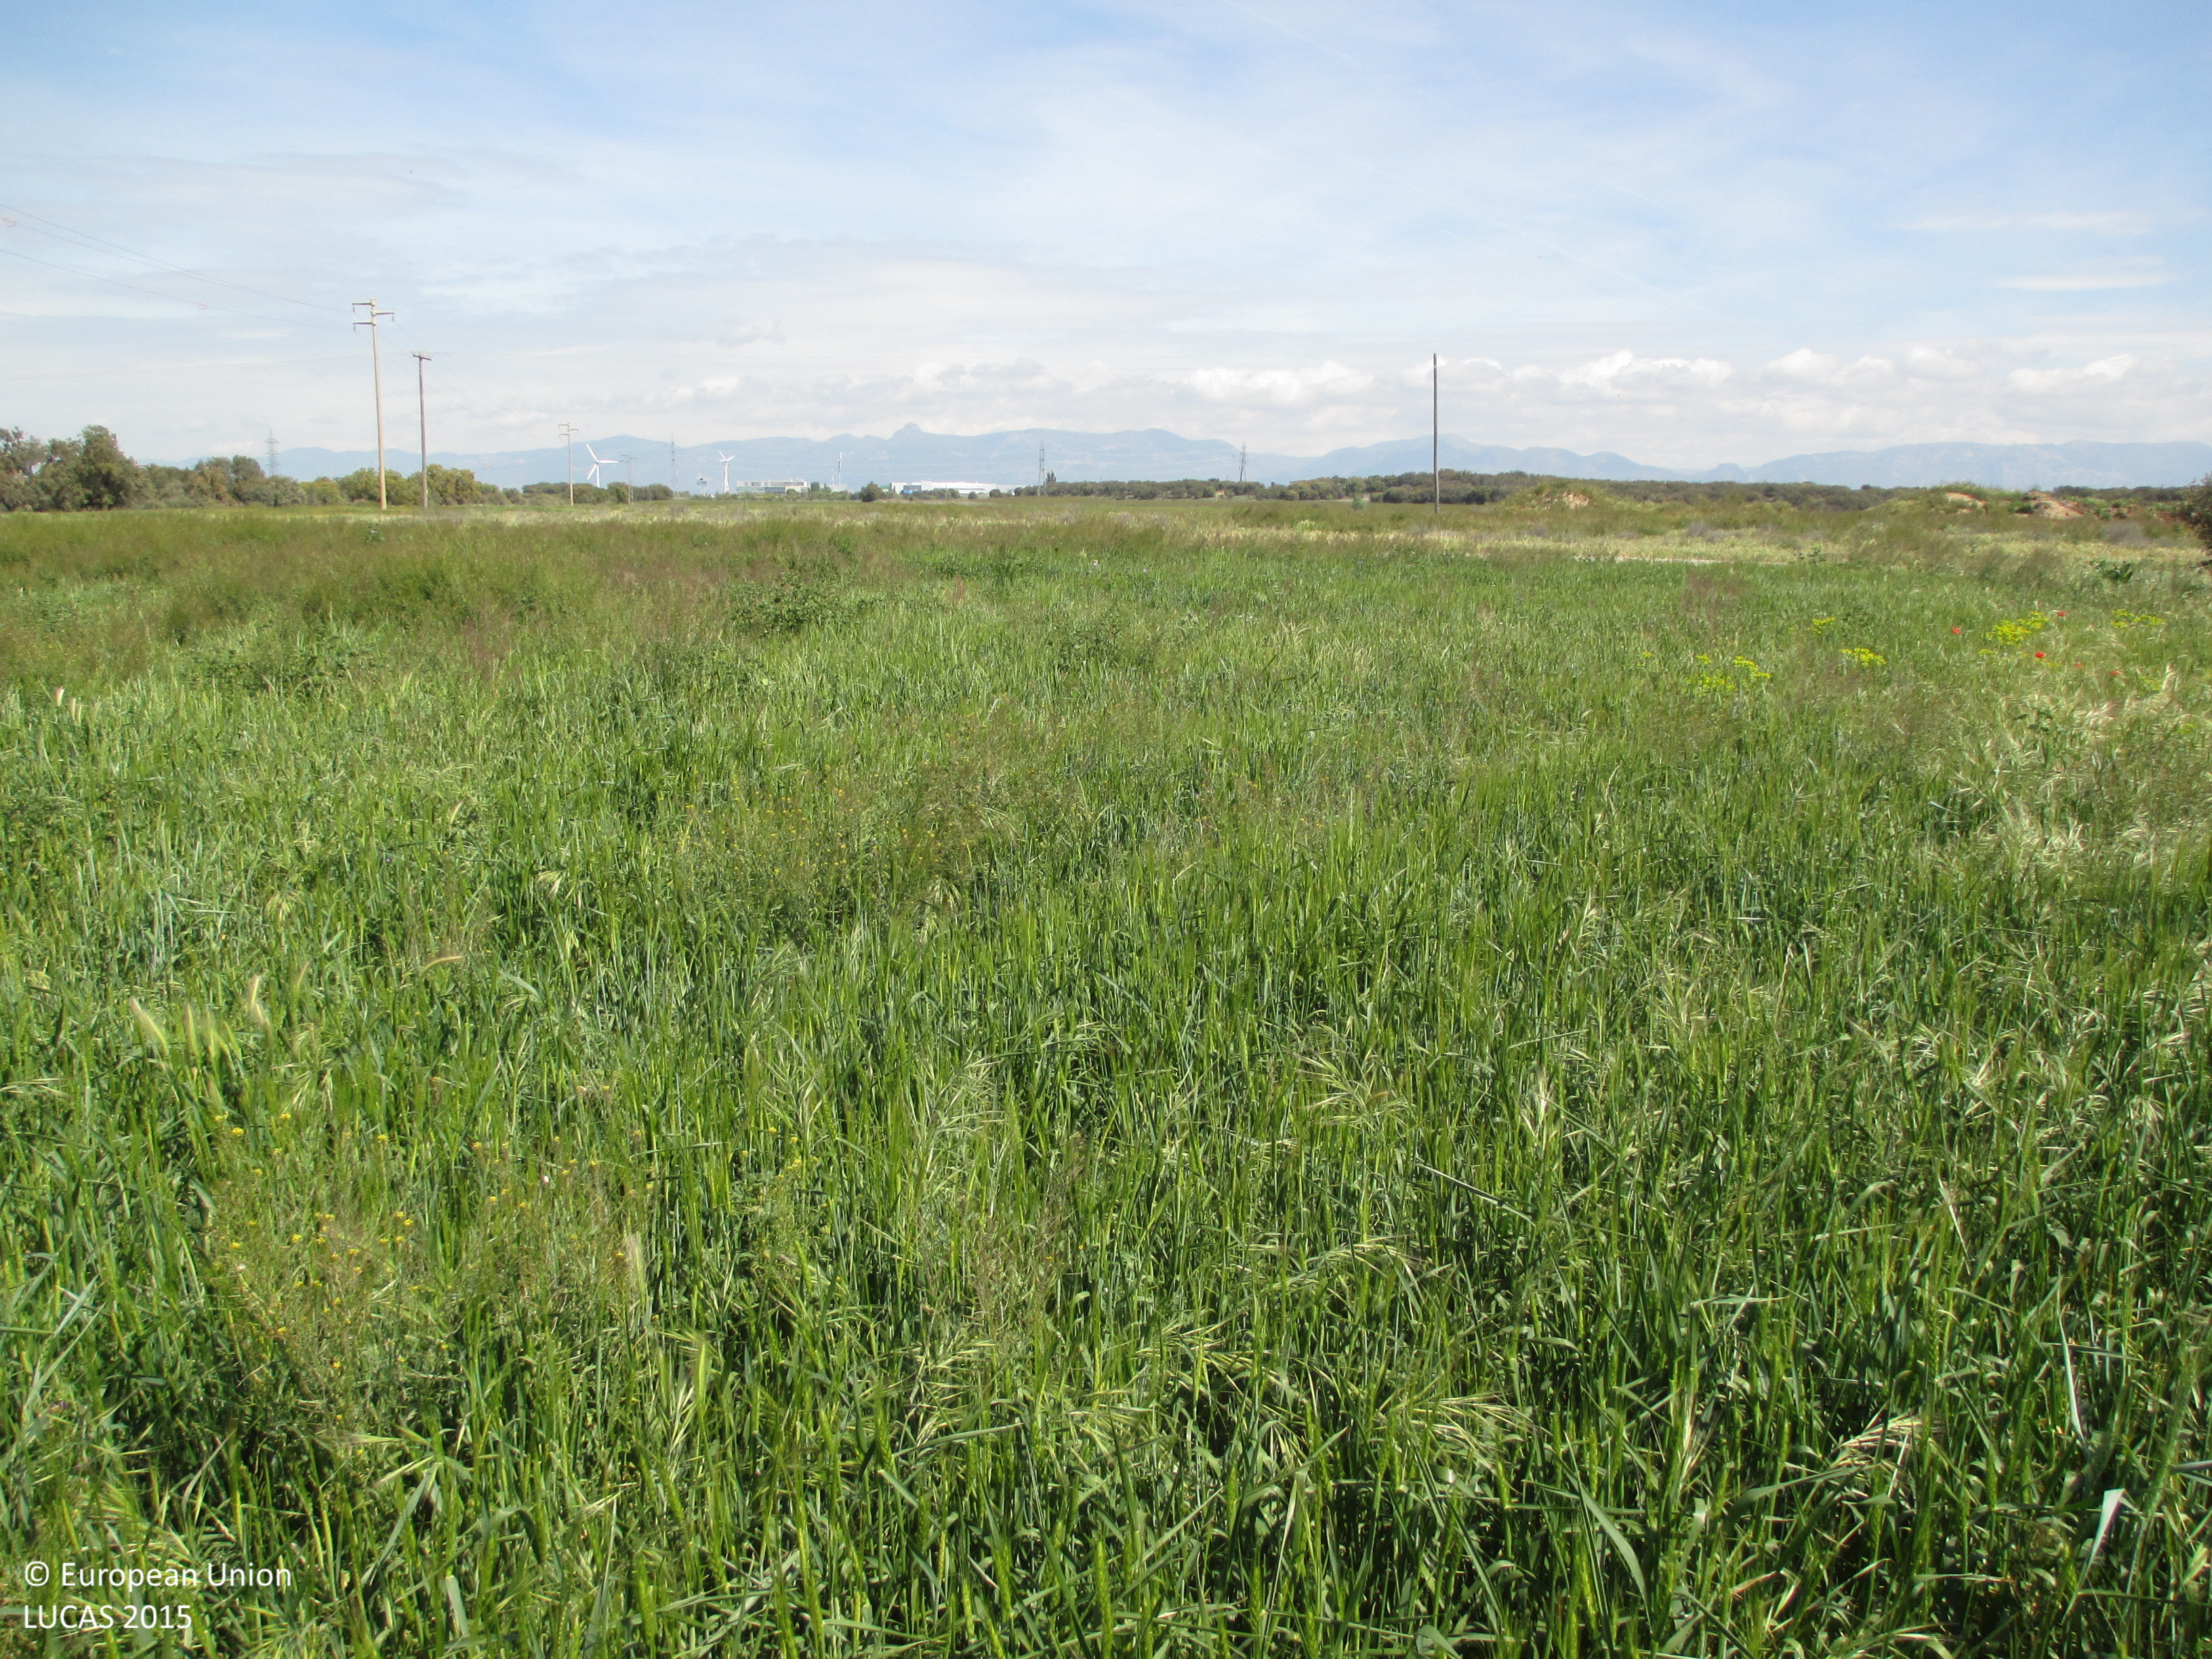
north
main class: Cropland
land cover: Common wheat
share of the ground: > 75 %
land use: Agriculture (excluding fallow land and kitchen gardens)
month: April
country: ES
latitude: 42.0931
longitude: -0.4566
